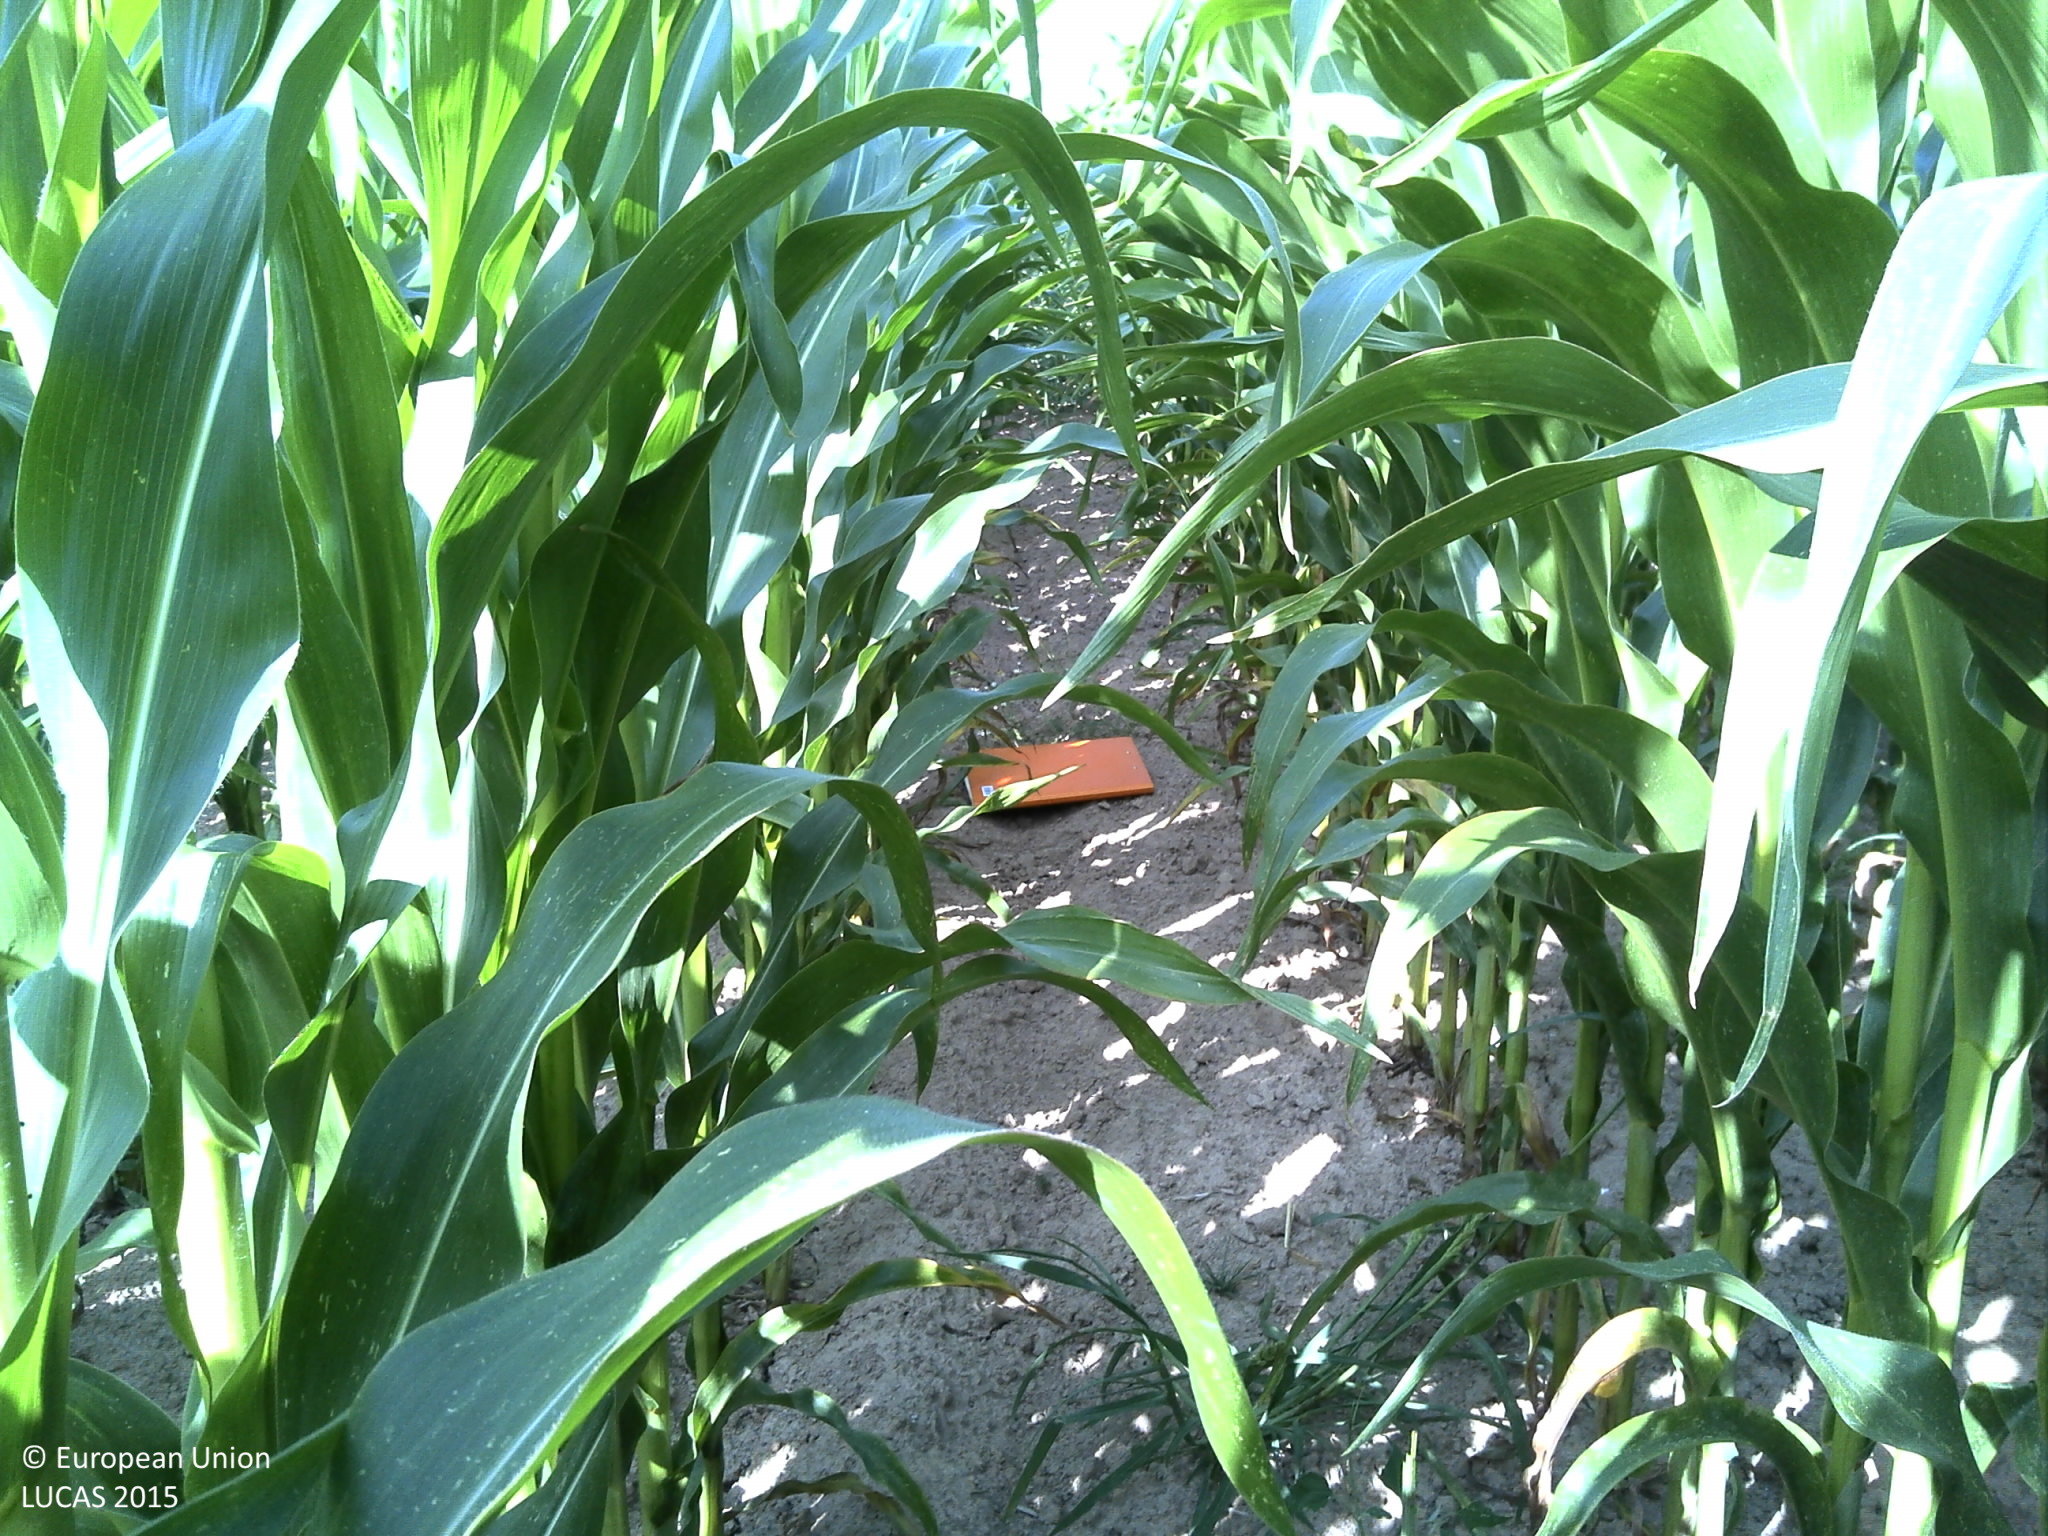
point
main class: Cropland
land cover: Maize
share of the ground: > 75 %
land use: Agriculture (excluding fallow land and kitchen gardens)
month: July
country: FR
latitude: 48.3583
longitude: 6.2620
